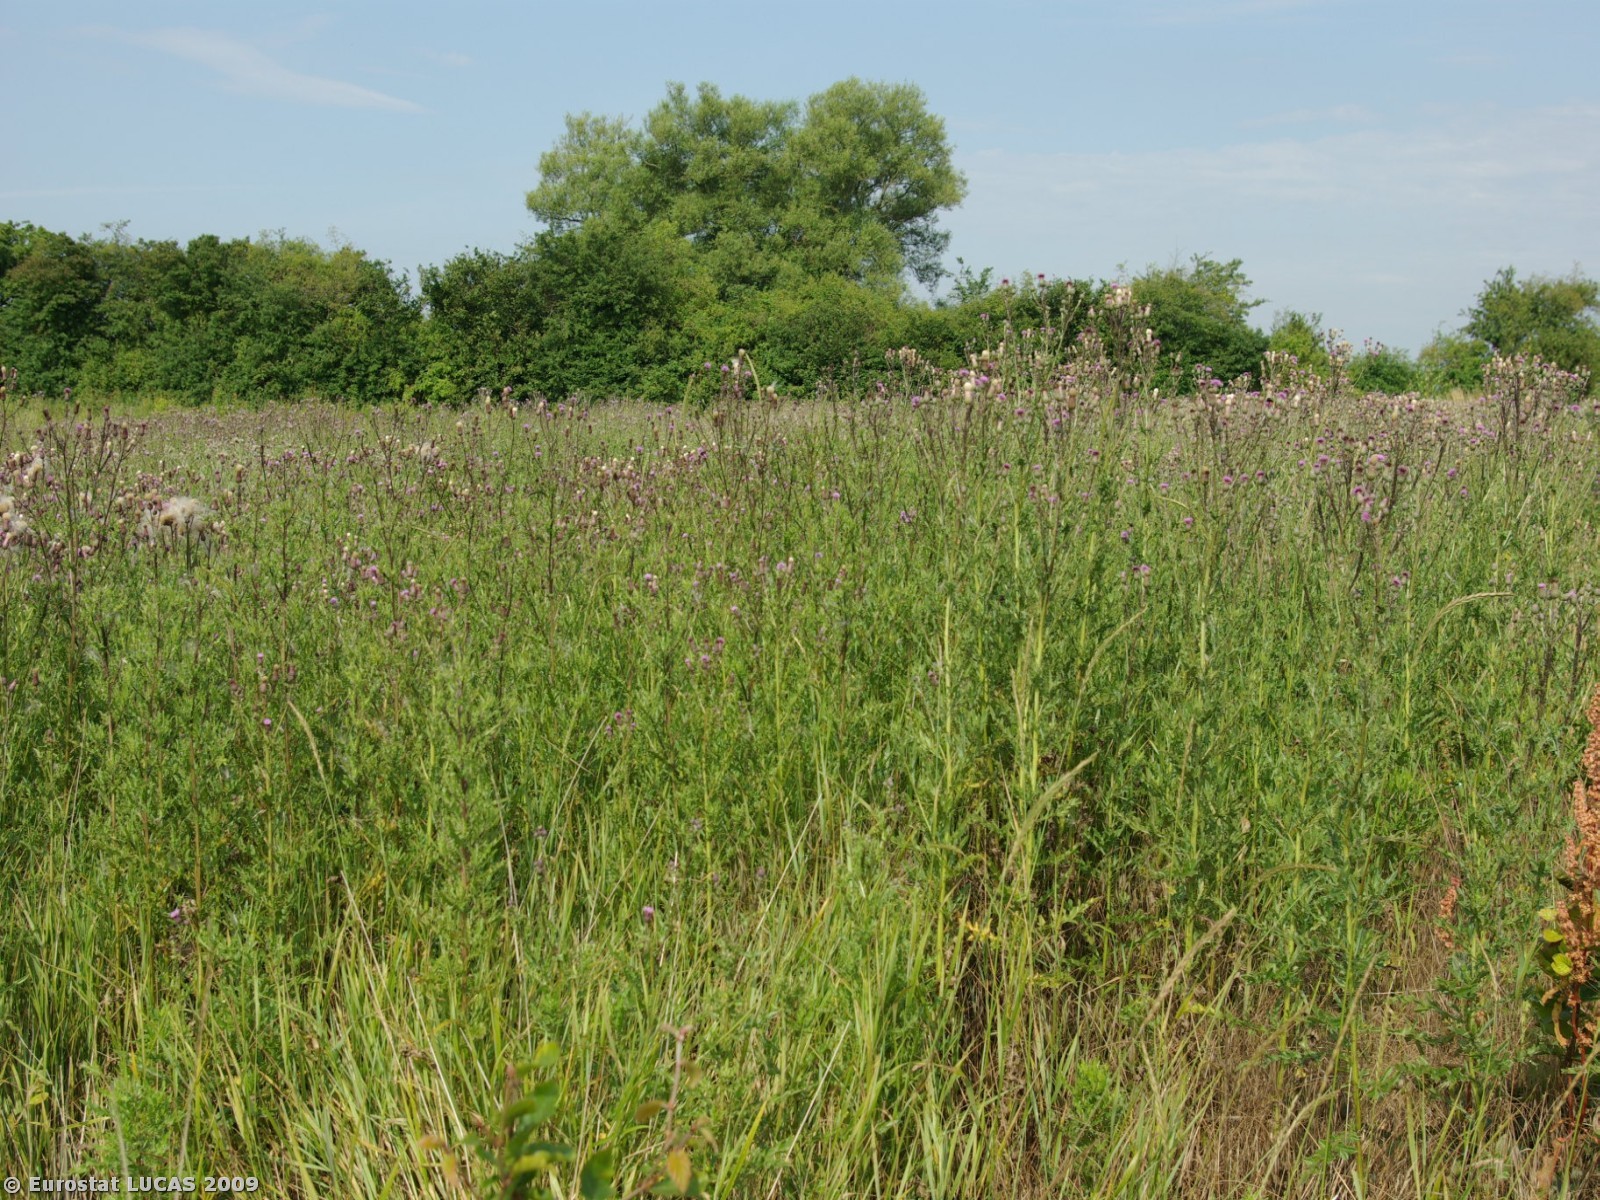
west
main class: Woodland
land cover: Broadleaved woodland
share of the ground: < 10 %
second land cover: Spontaneously vegetated surfaces
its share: > 75 %
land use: Amenities, museums, leisure
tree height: < 5 m
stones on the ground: < 10 %
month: July
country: DK
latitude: 54.9291
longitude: 9.6725
